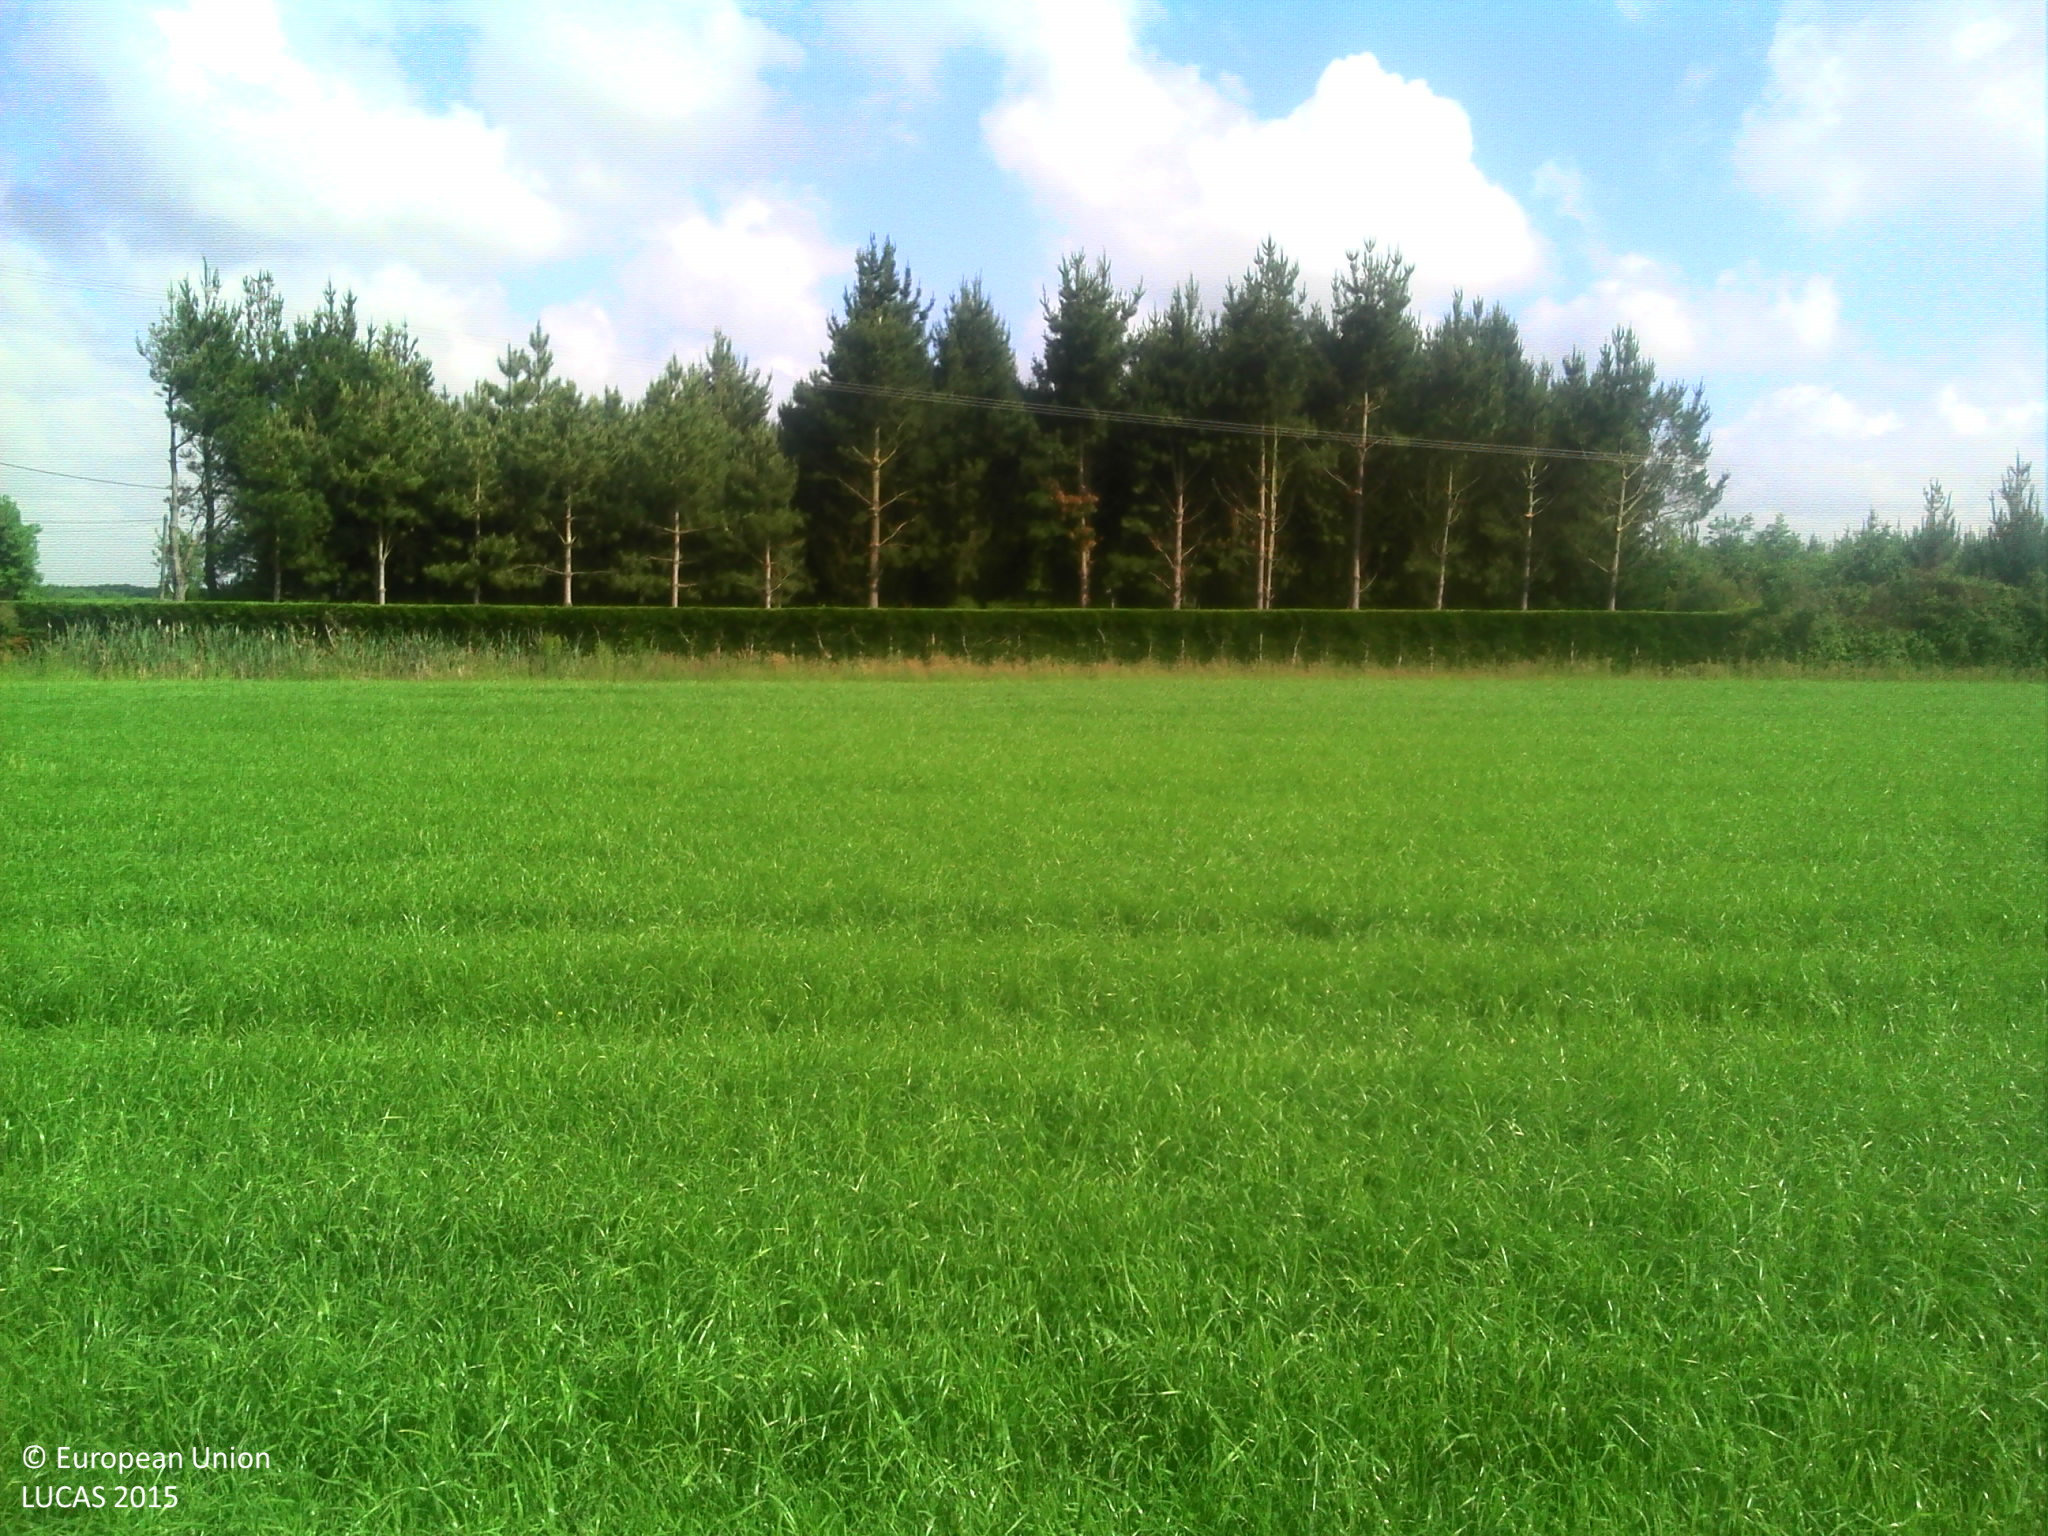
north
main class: Cropland
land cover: Temporary grasslands
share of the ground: > 75 %
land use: Agriculture (excluding fallow land and kitchen gardens)
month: May
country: FR
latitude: 47.4733
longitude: -0.9828
